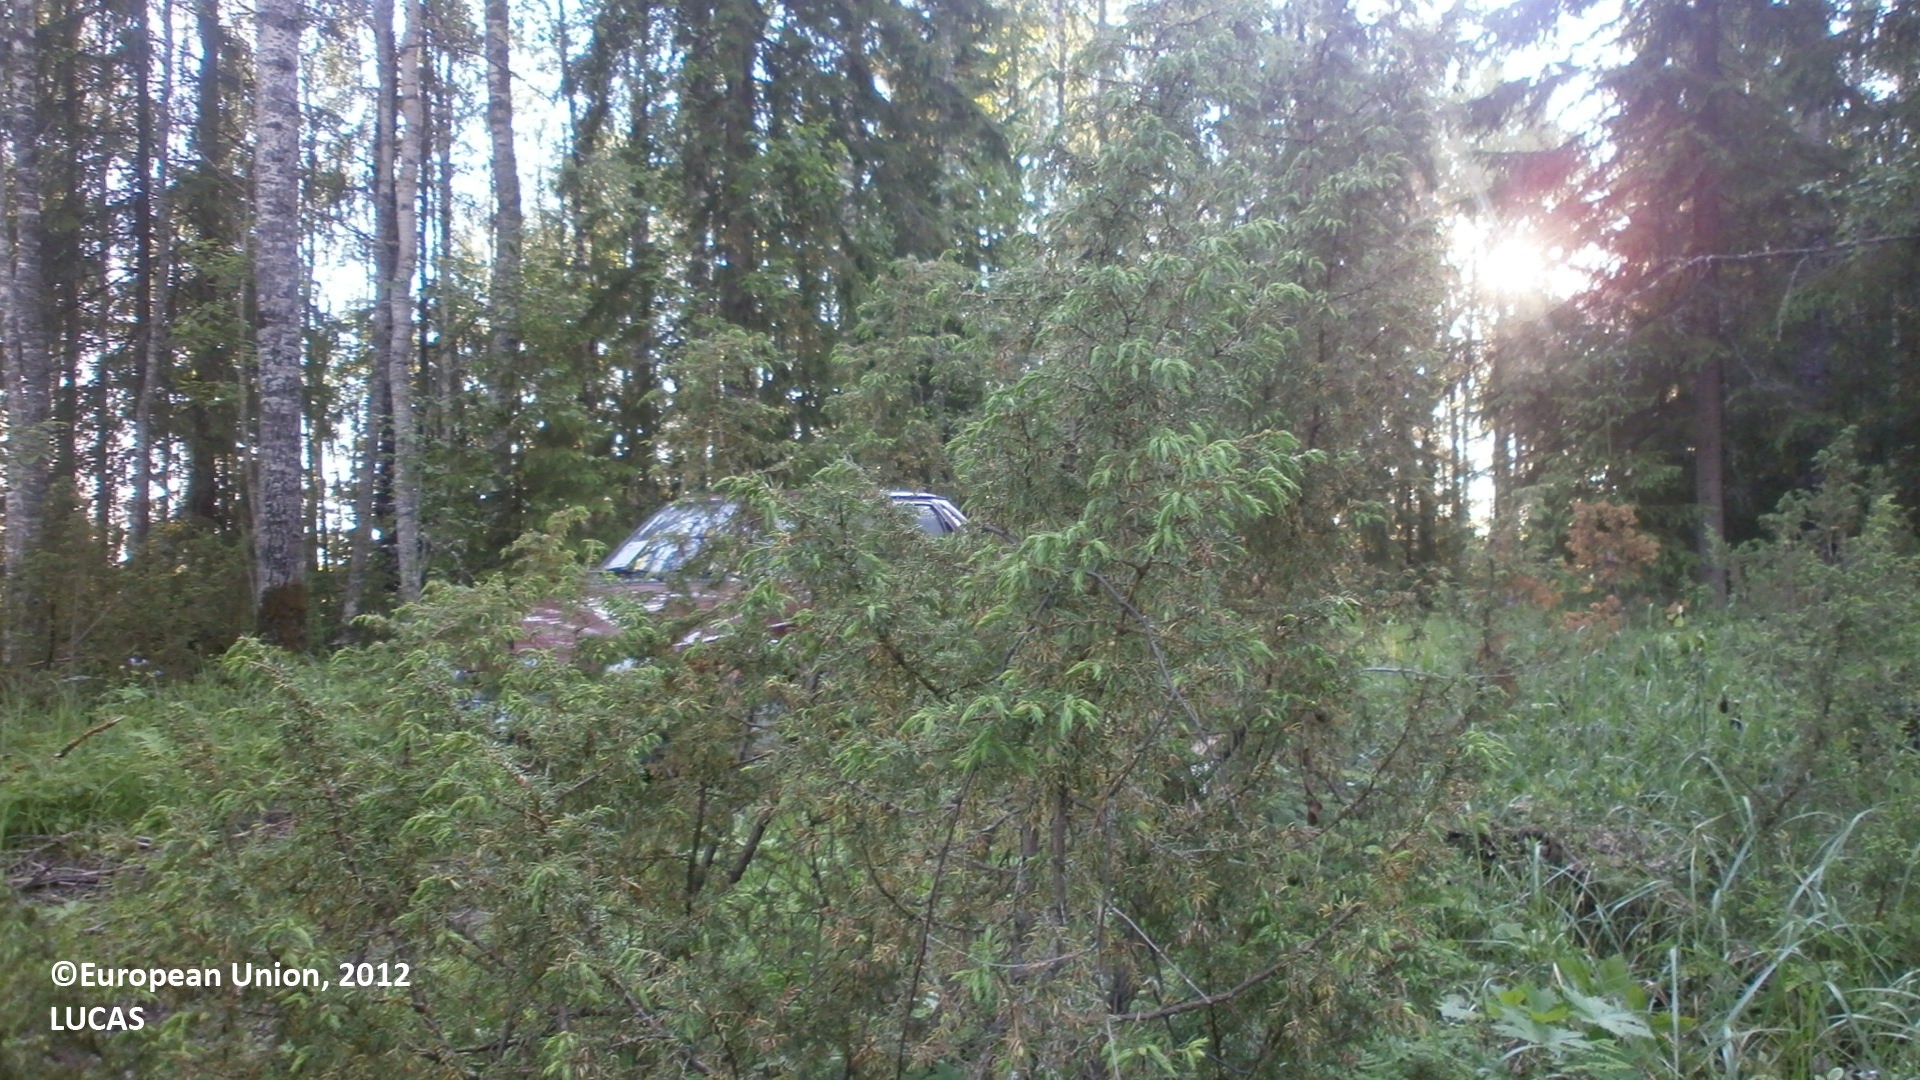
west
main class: Woodland
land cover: Other mixed woodland
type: boreal forest
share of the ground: > 75 %
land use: Amenities, museums, leisure
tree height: > 5 m
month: June
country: FI
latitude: 64.3121
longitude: 24.9467
